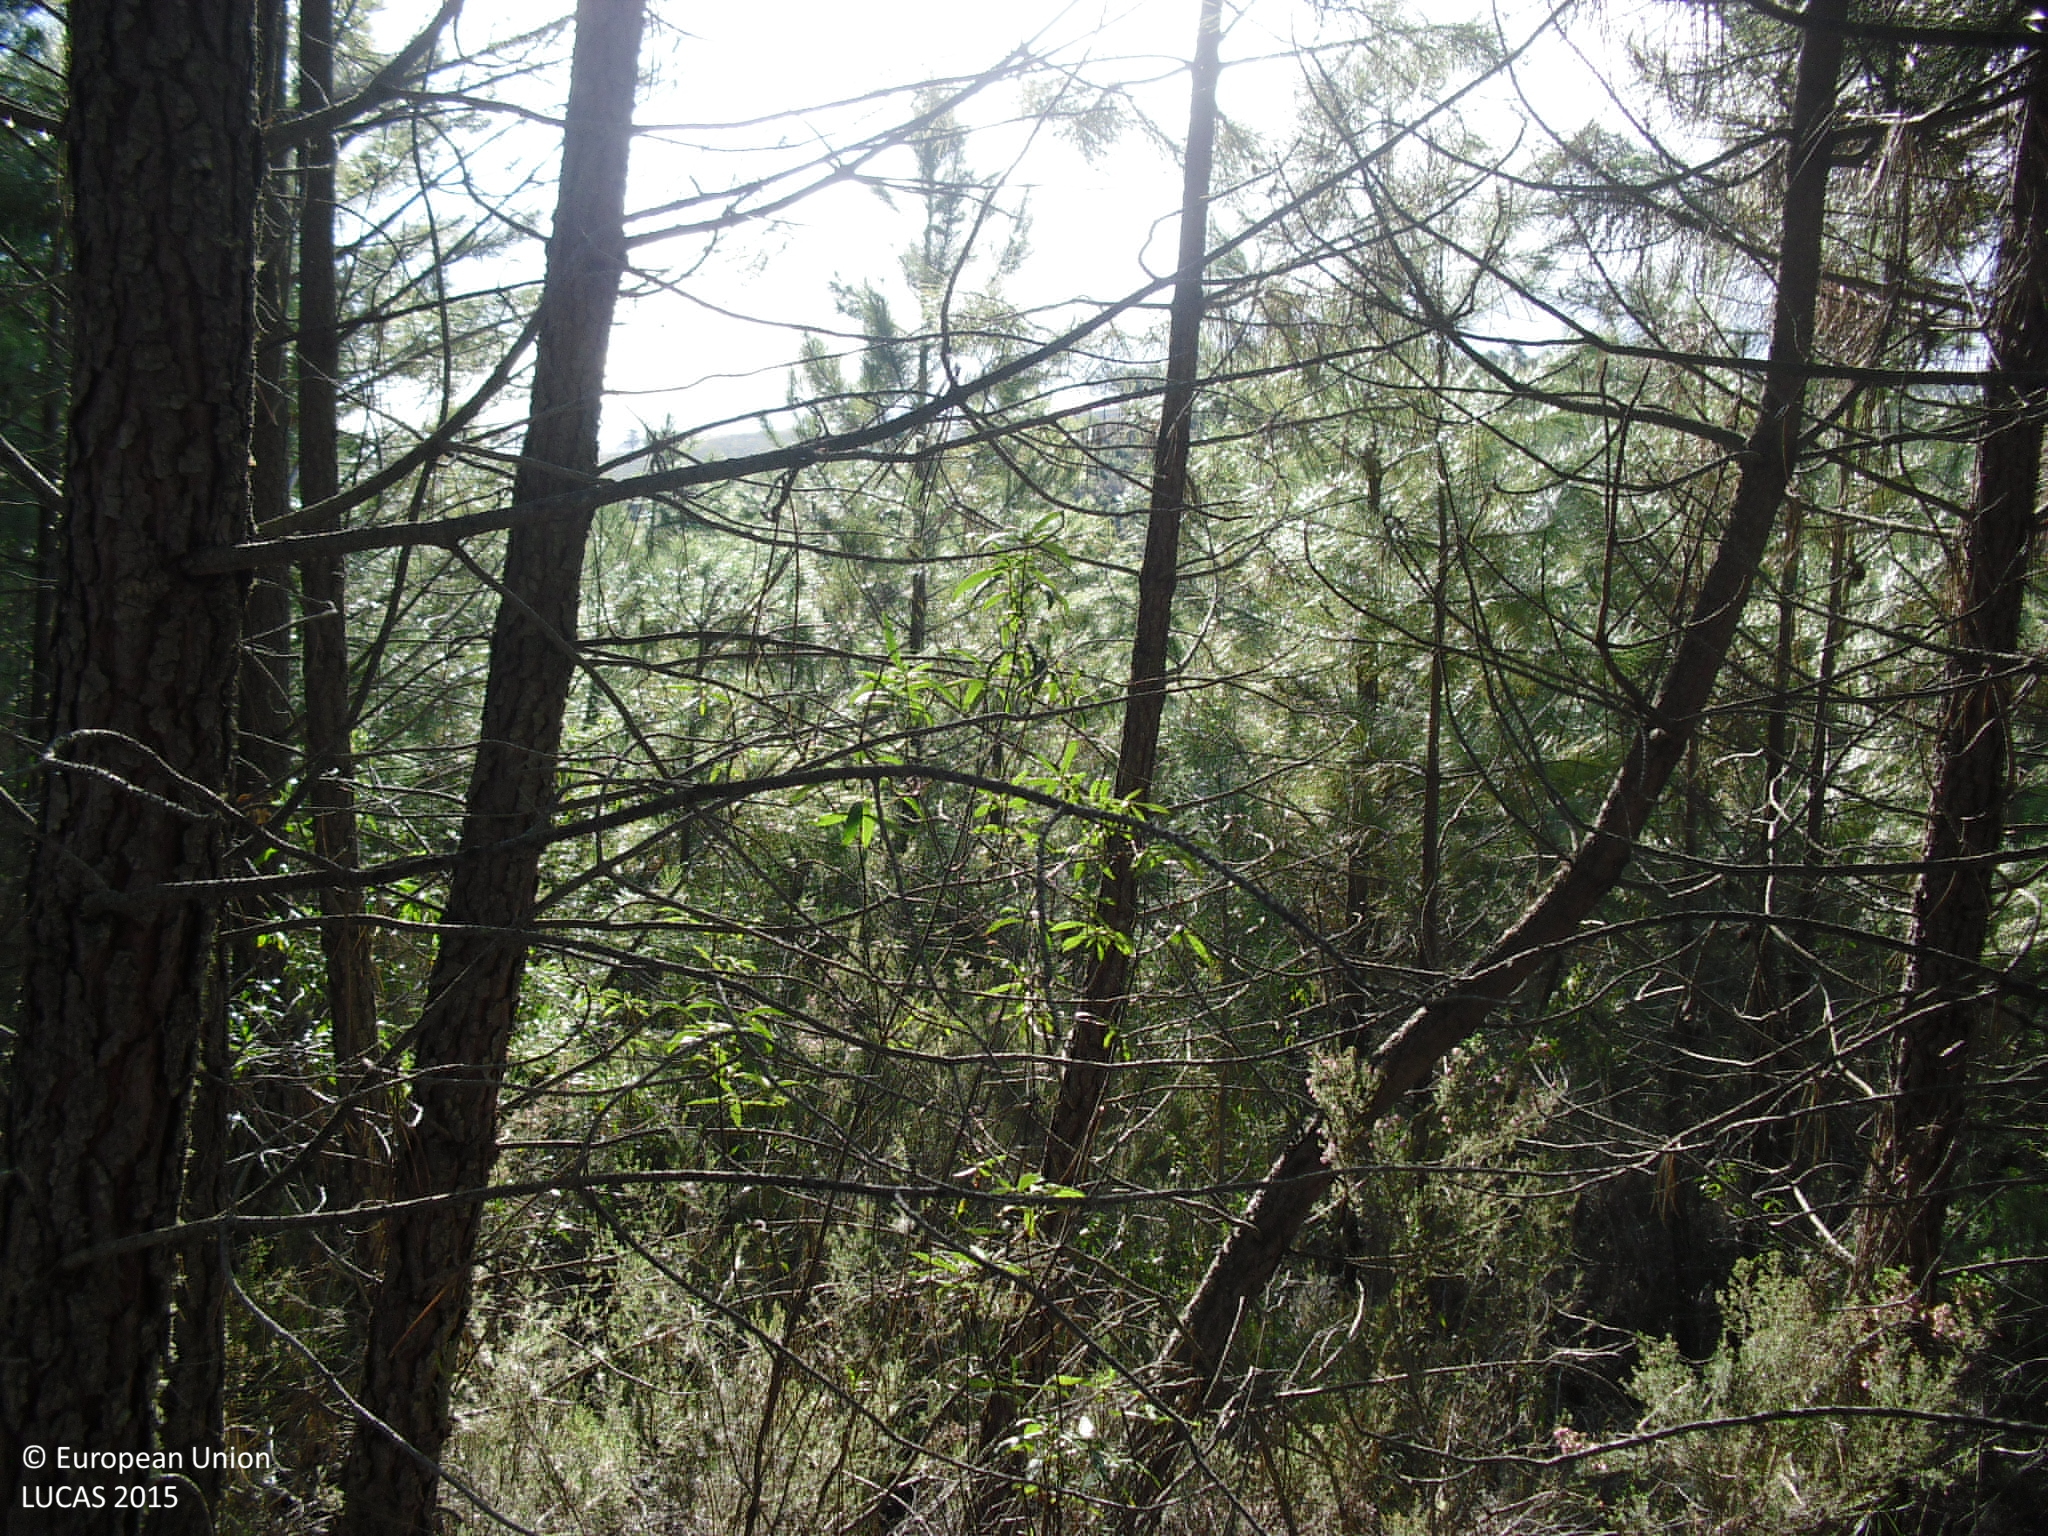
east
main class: Woodland
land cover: Pine dominated coniferous woodland
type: coniferous forest of the mediterranean region
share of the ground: > 75 %
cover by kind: coniferous forest trees 100 %
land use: Forestry
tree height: > 5 m
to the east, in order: Pine dominated coniferous woodland; Broadleaved woodland; Tracks; Broadleaved woodland; Rivers and streams; Broadleaved woodland; Grass margins; Fences; Paved roads, cycling and walking lanes; Broadleaved woodland
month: April
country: ES
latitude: 39.4941
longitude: -5.3398
